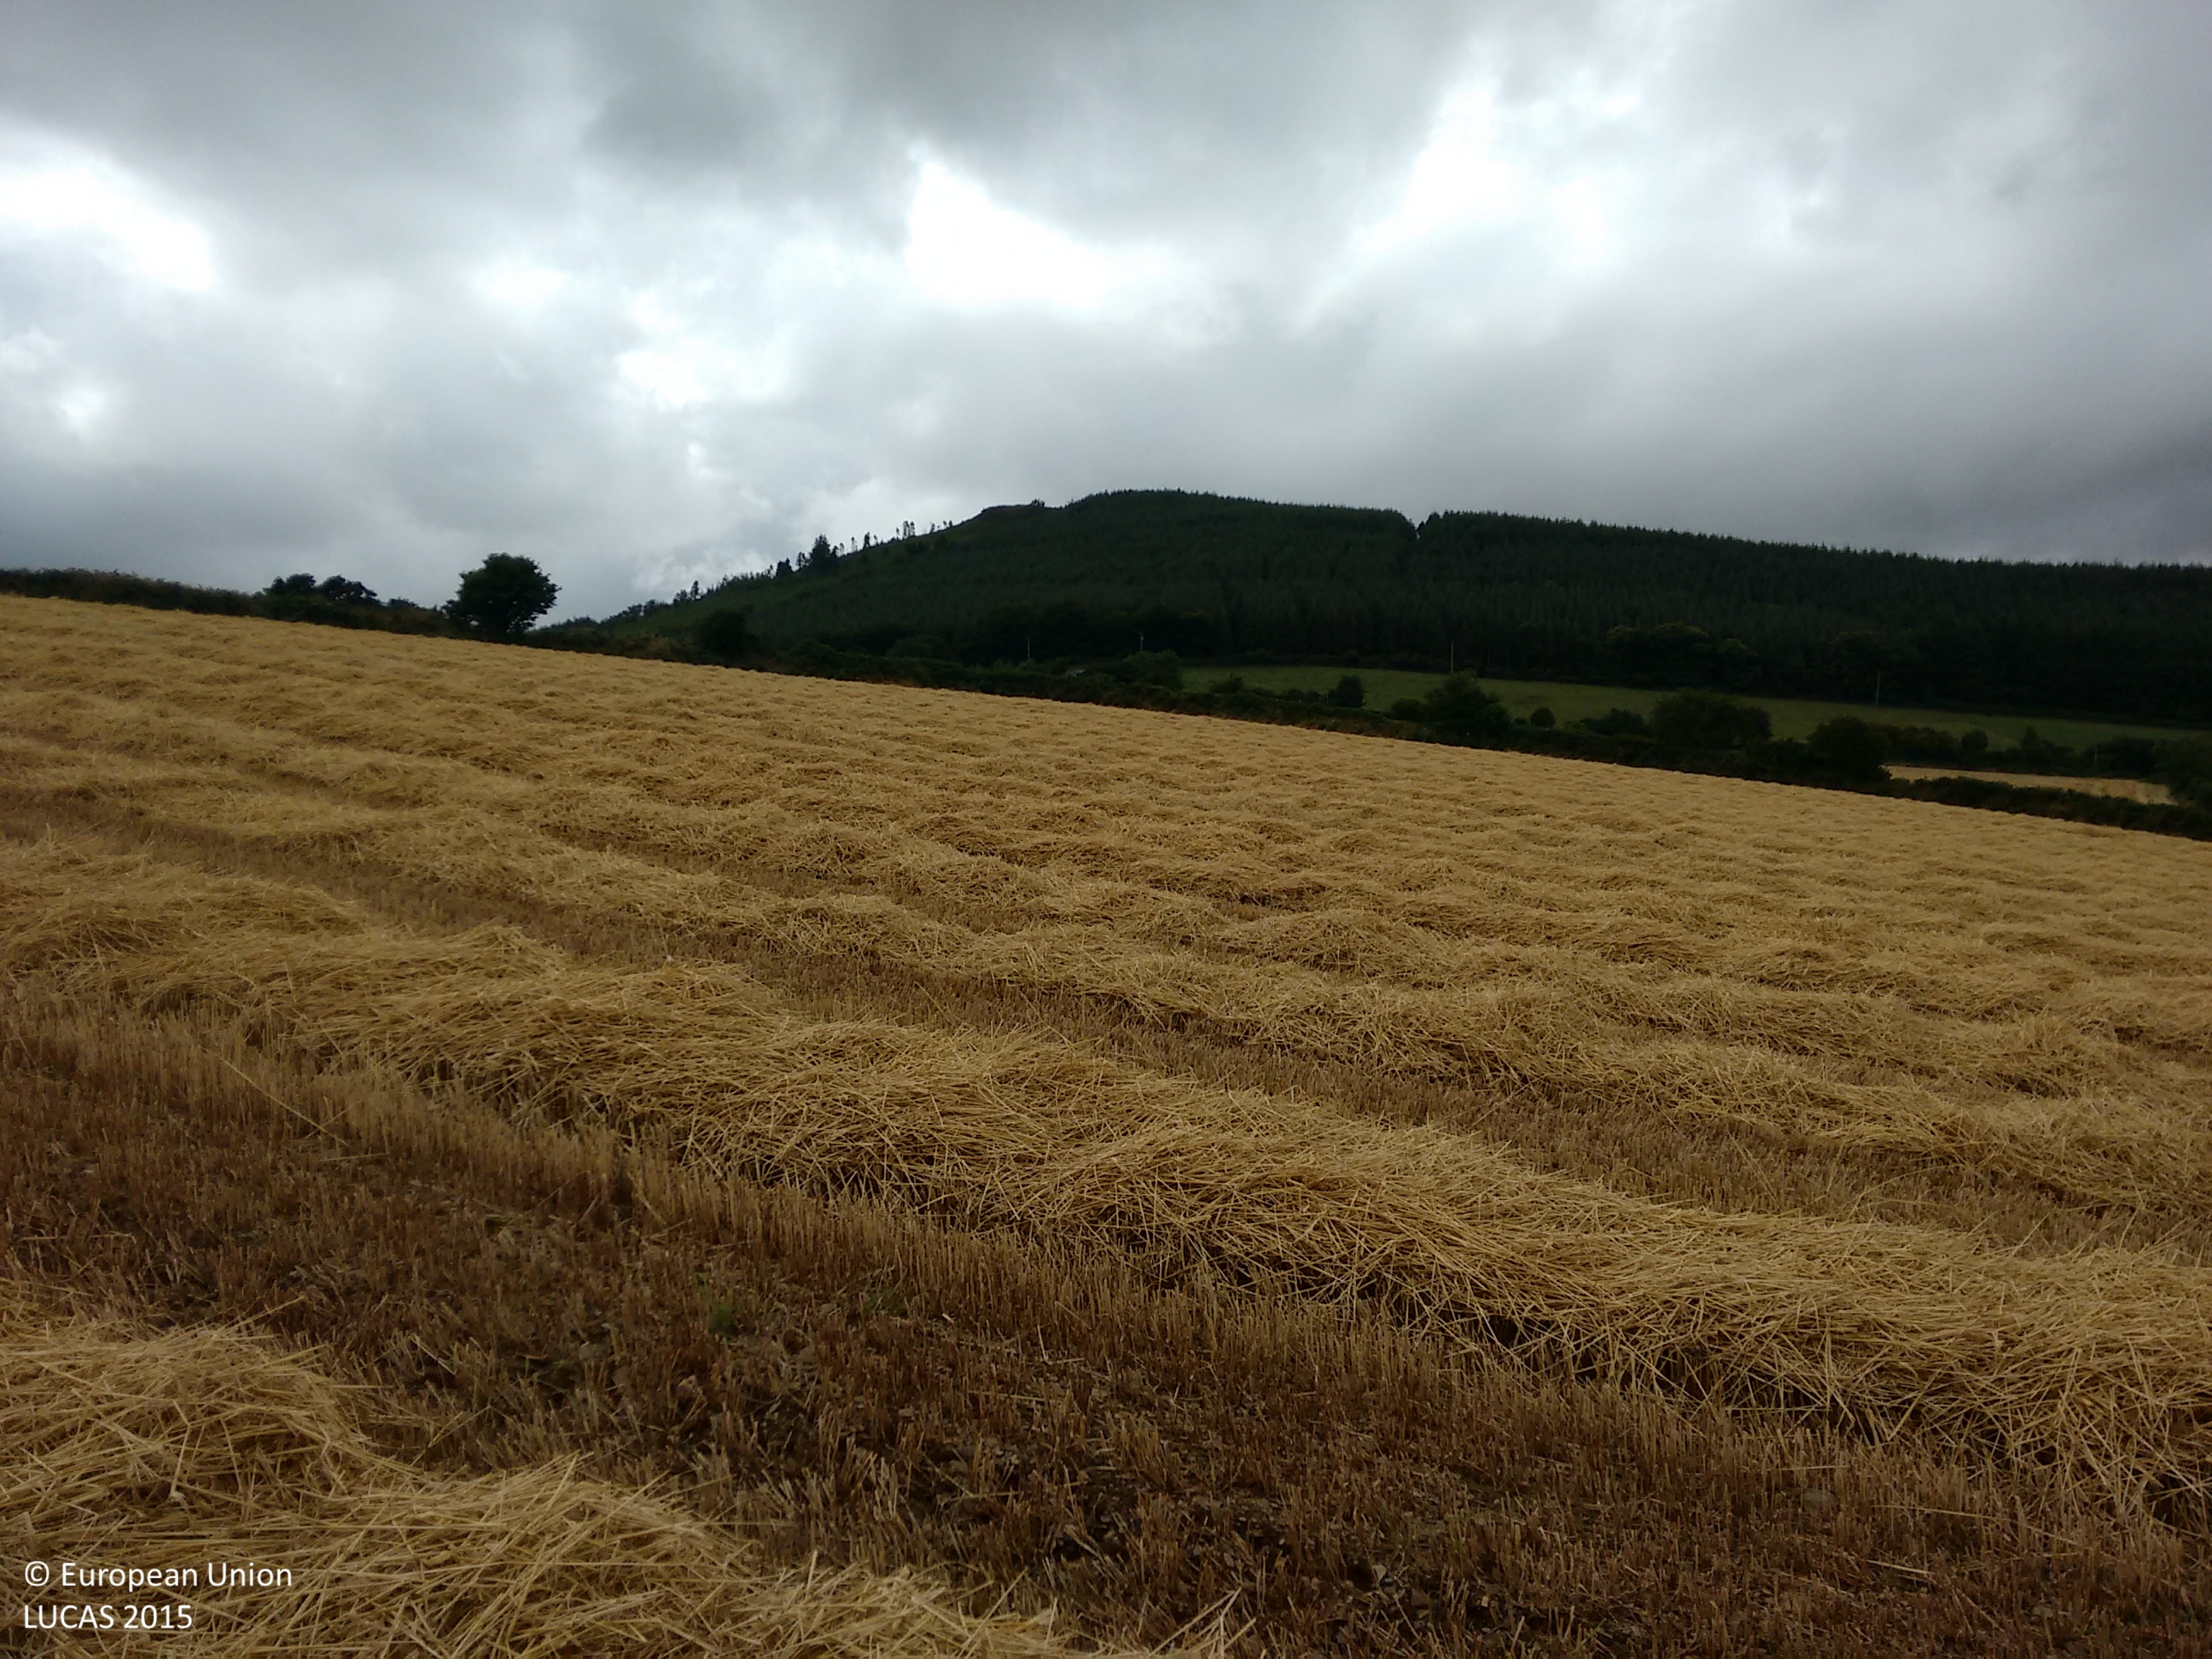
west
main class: Cropland
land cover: Barley
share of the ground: > 75 %
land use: Agriculture (excluding fallow land and kitchen gardens)
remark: Harvested field
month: August
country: IE
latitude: 52.6715
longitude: -6.4375
